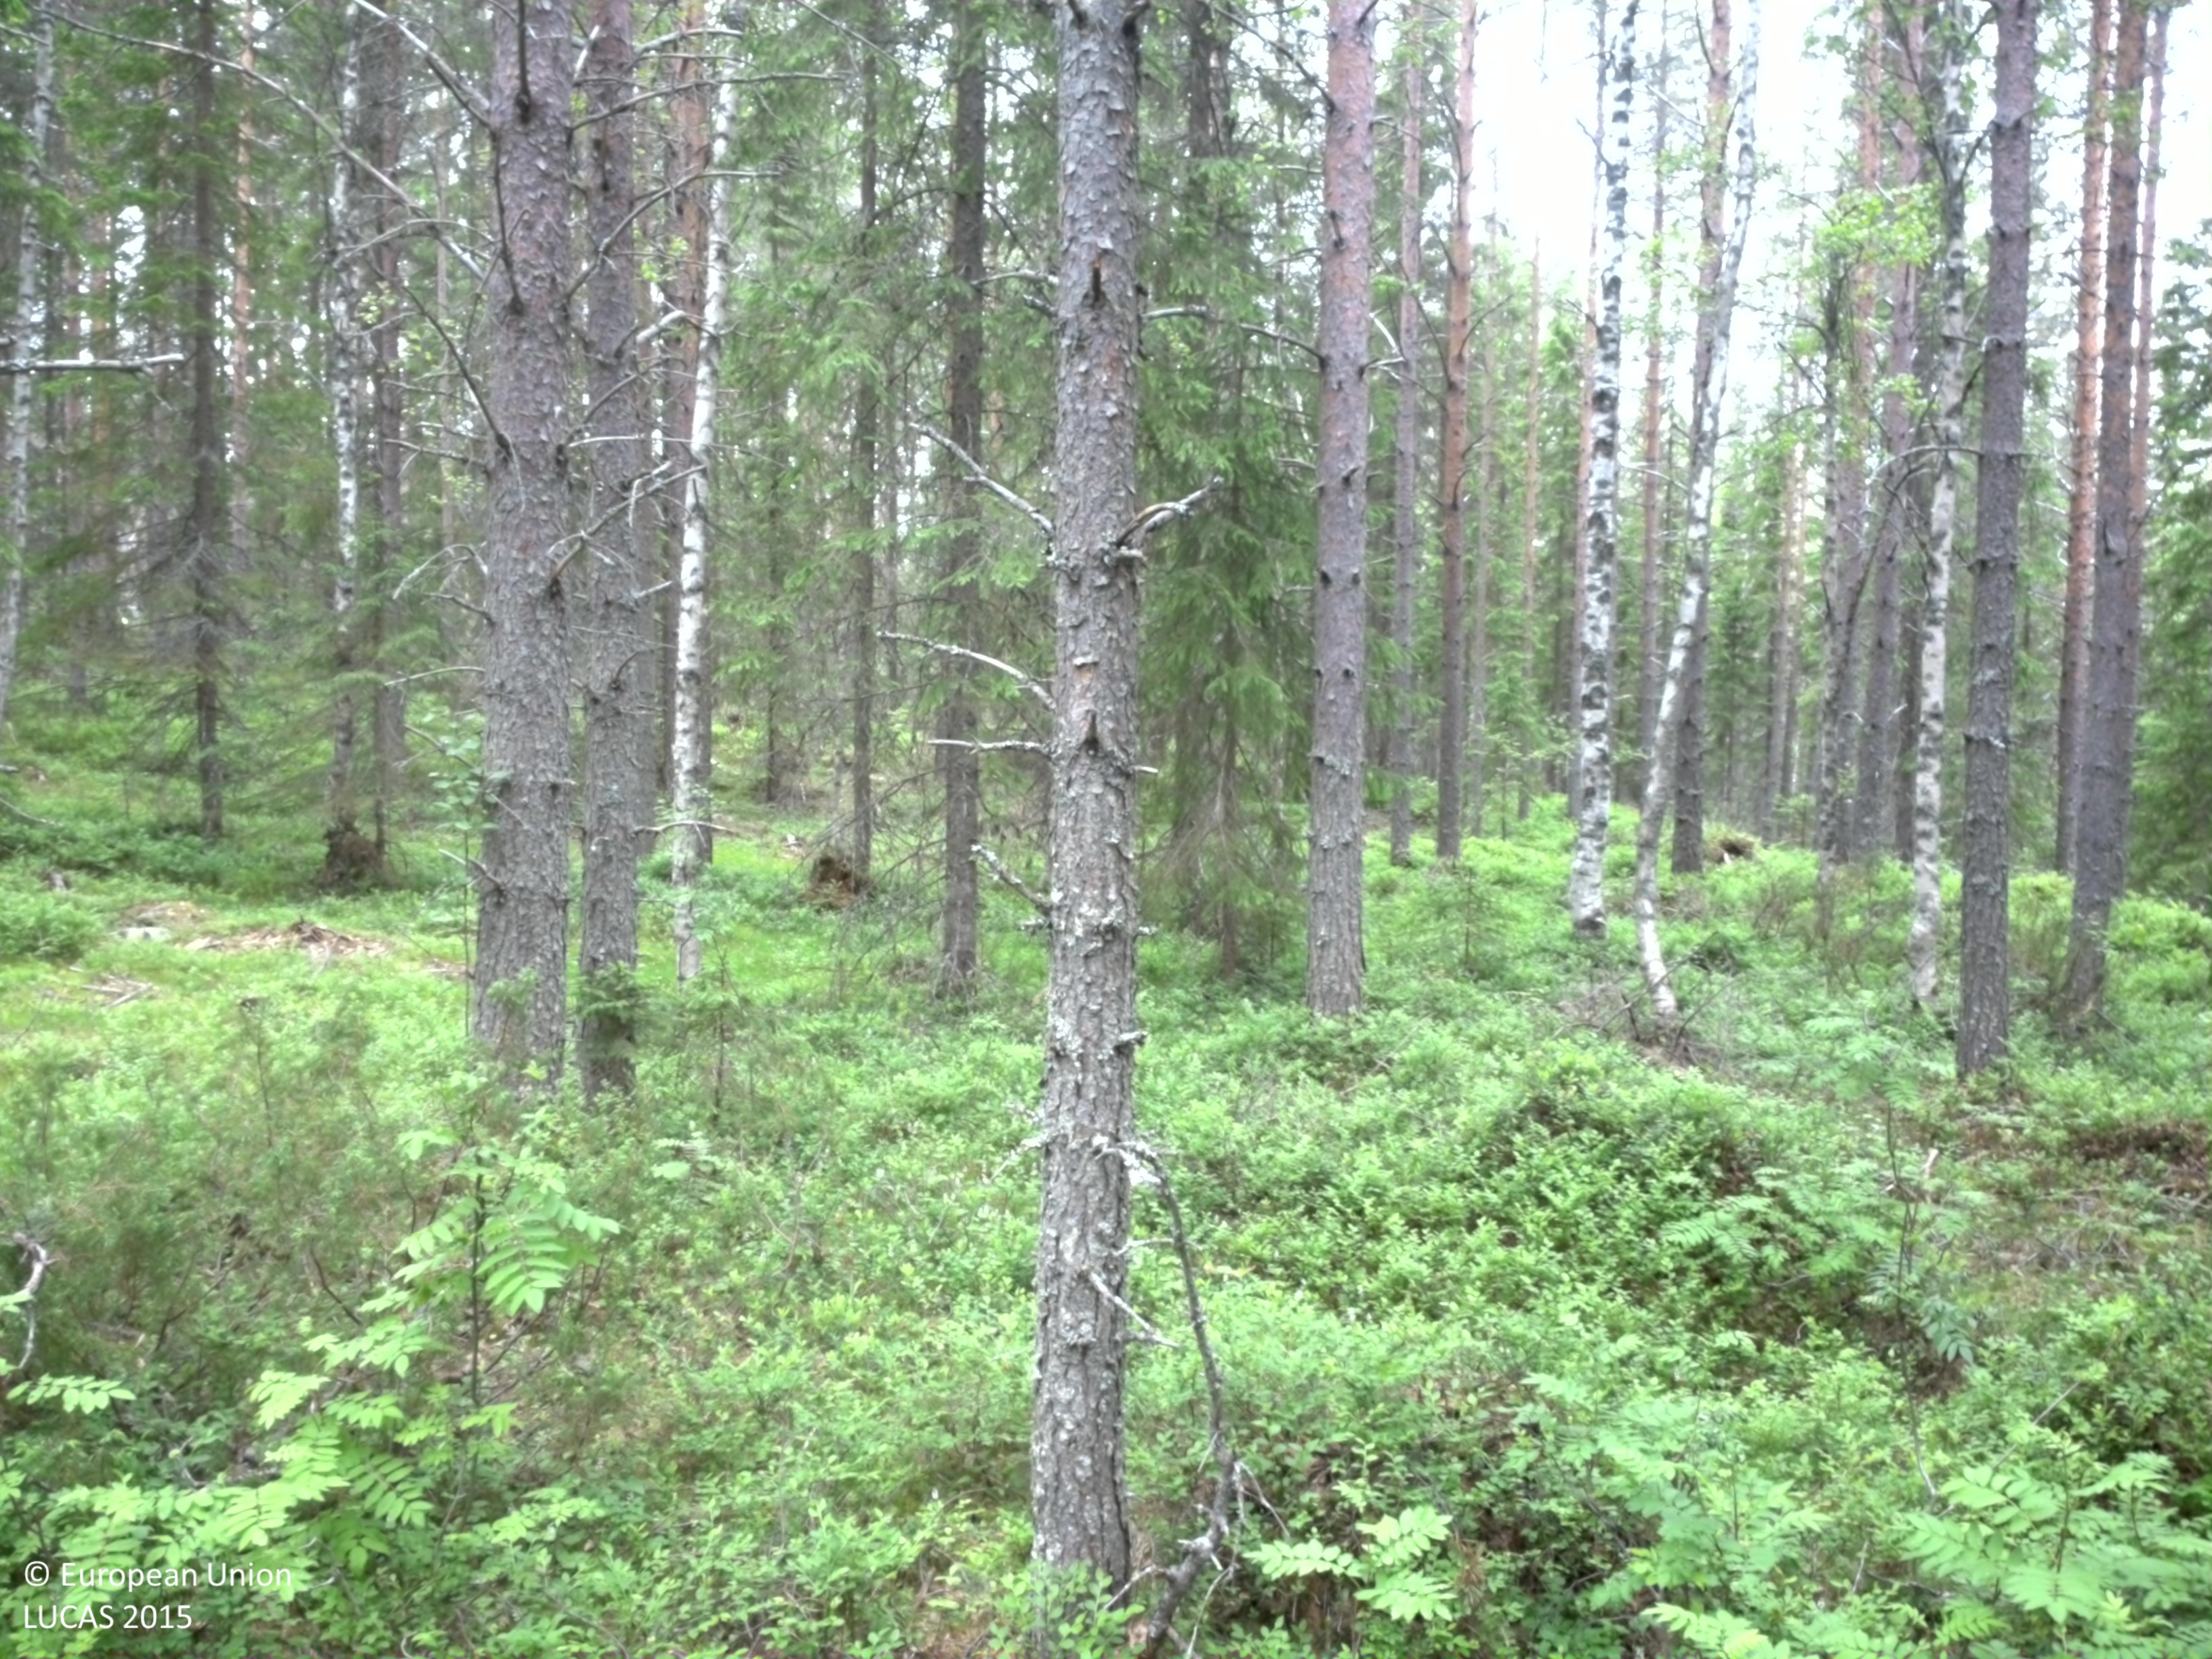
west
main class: Woodland
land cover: Other coniferous woodland
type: boreal forest
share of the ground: 50 - 75 %
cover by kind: coniferous forest trees 65 %, shrubs 25 %, broadleaved forest trees 10 %
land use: Forestry
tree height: > 5 m
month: July
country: SE
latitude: 64.4512
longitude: 20.7651
